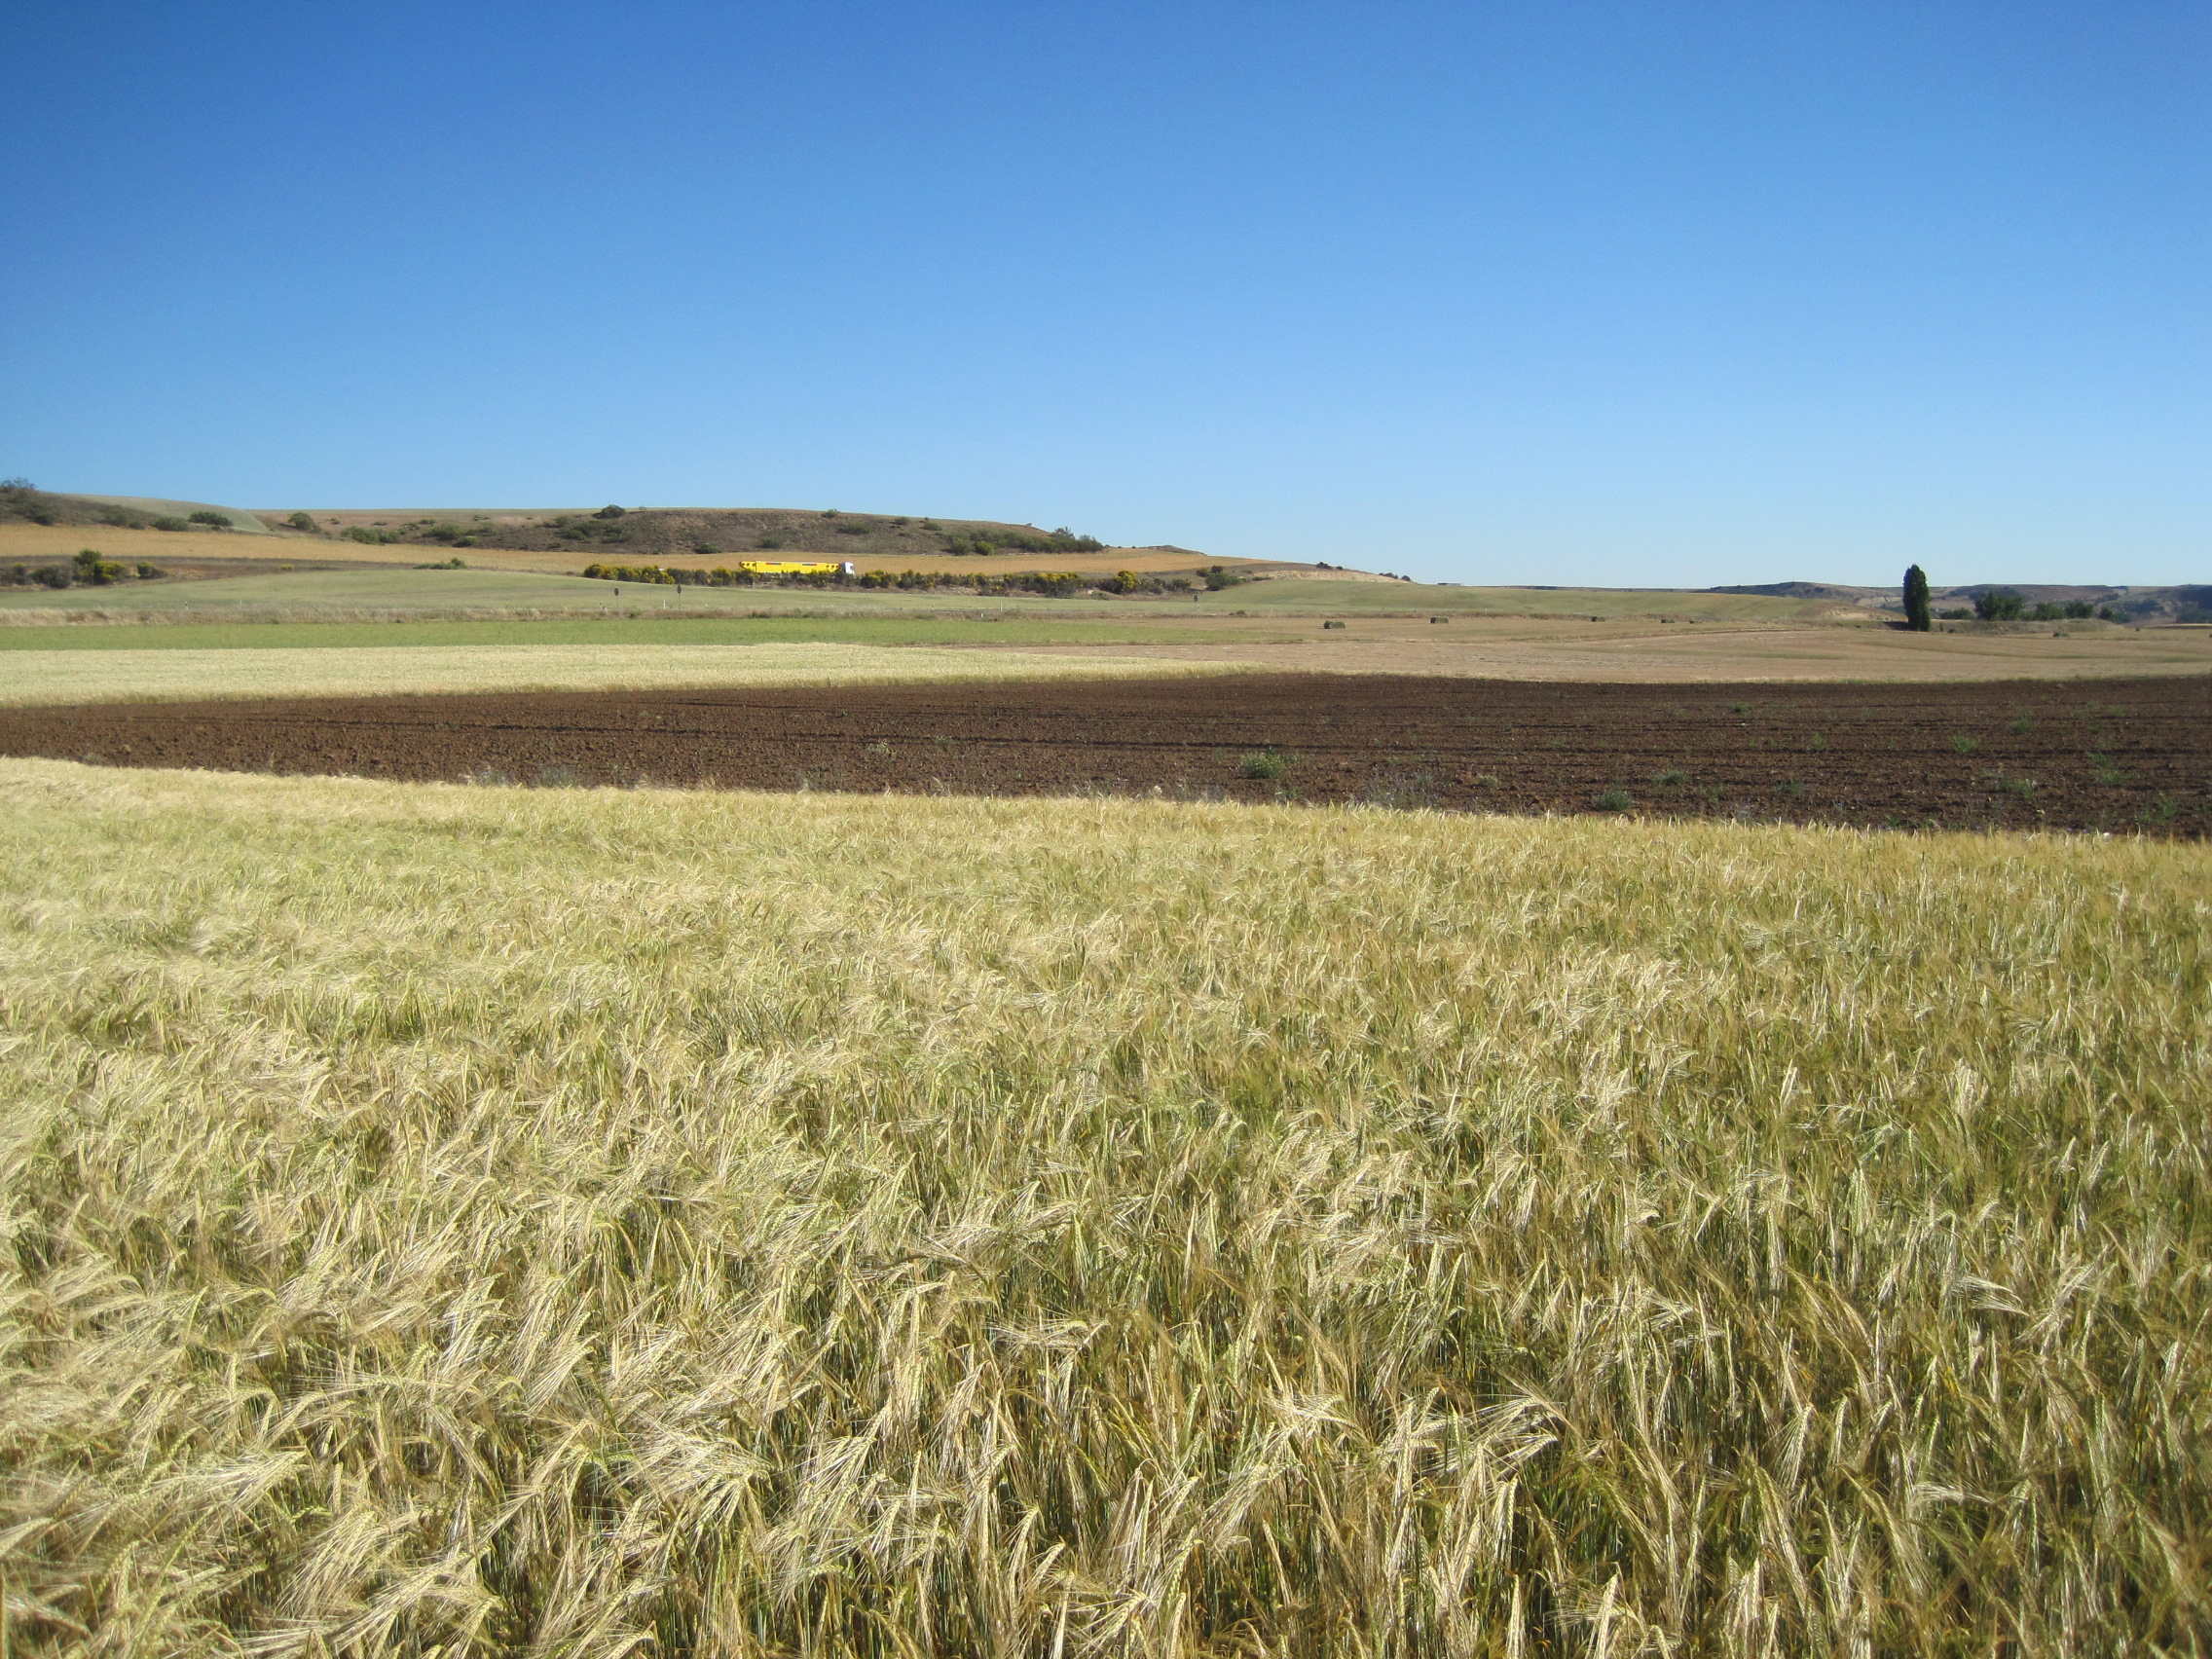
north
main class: Cropland
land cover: Barley
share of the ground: > 75 %
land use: Agriculture (excluding fallow land and kitchen gardens)
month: May
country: ES
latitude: 41.2042
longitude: -5.3267
